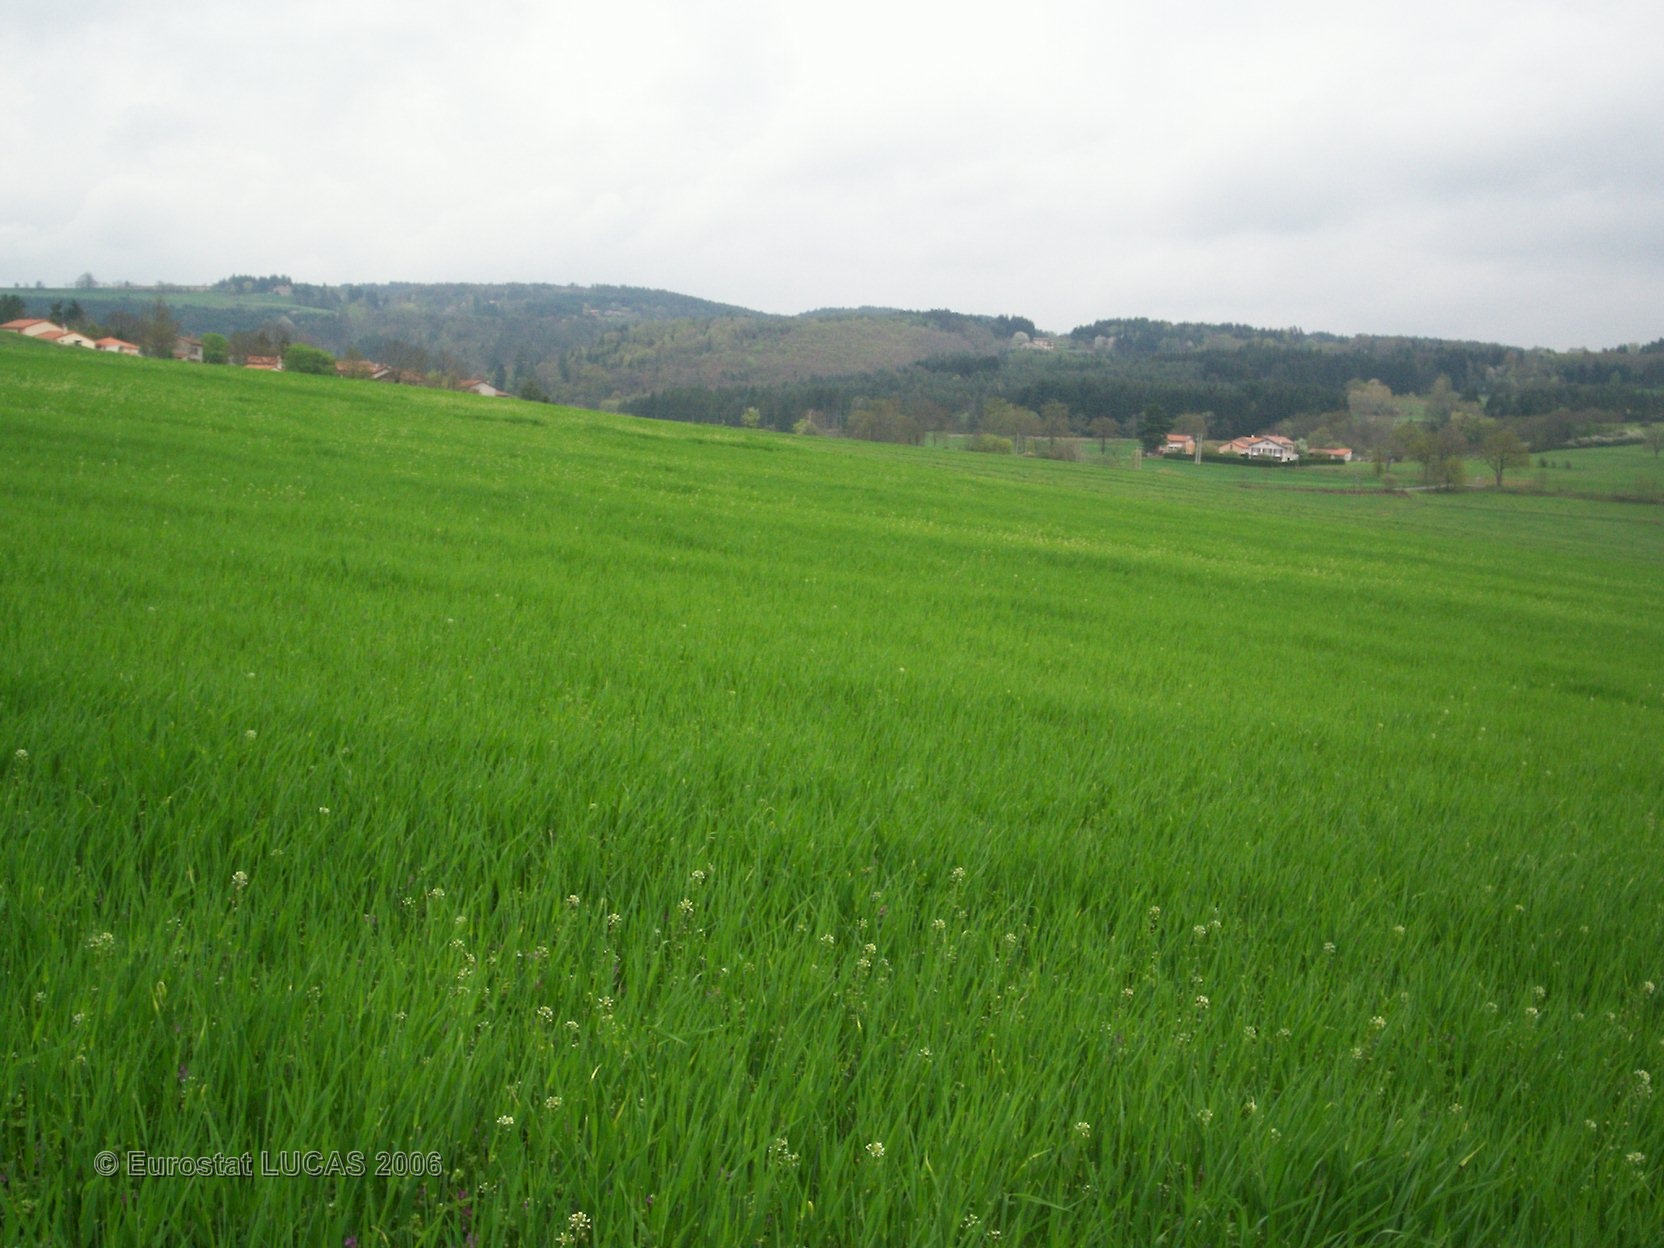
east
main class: Cropland
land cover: Barley
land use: Agriculture (excluding fallow land and kitchen gardens)
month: April
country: FR
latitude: 45.3075
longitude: 4.1752
